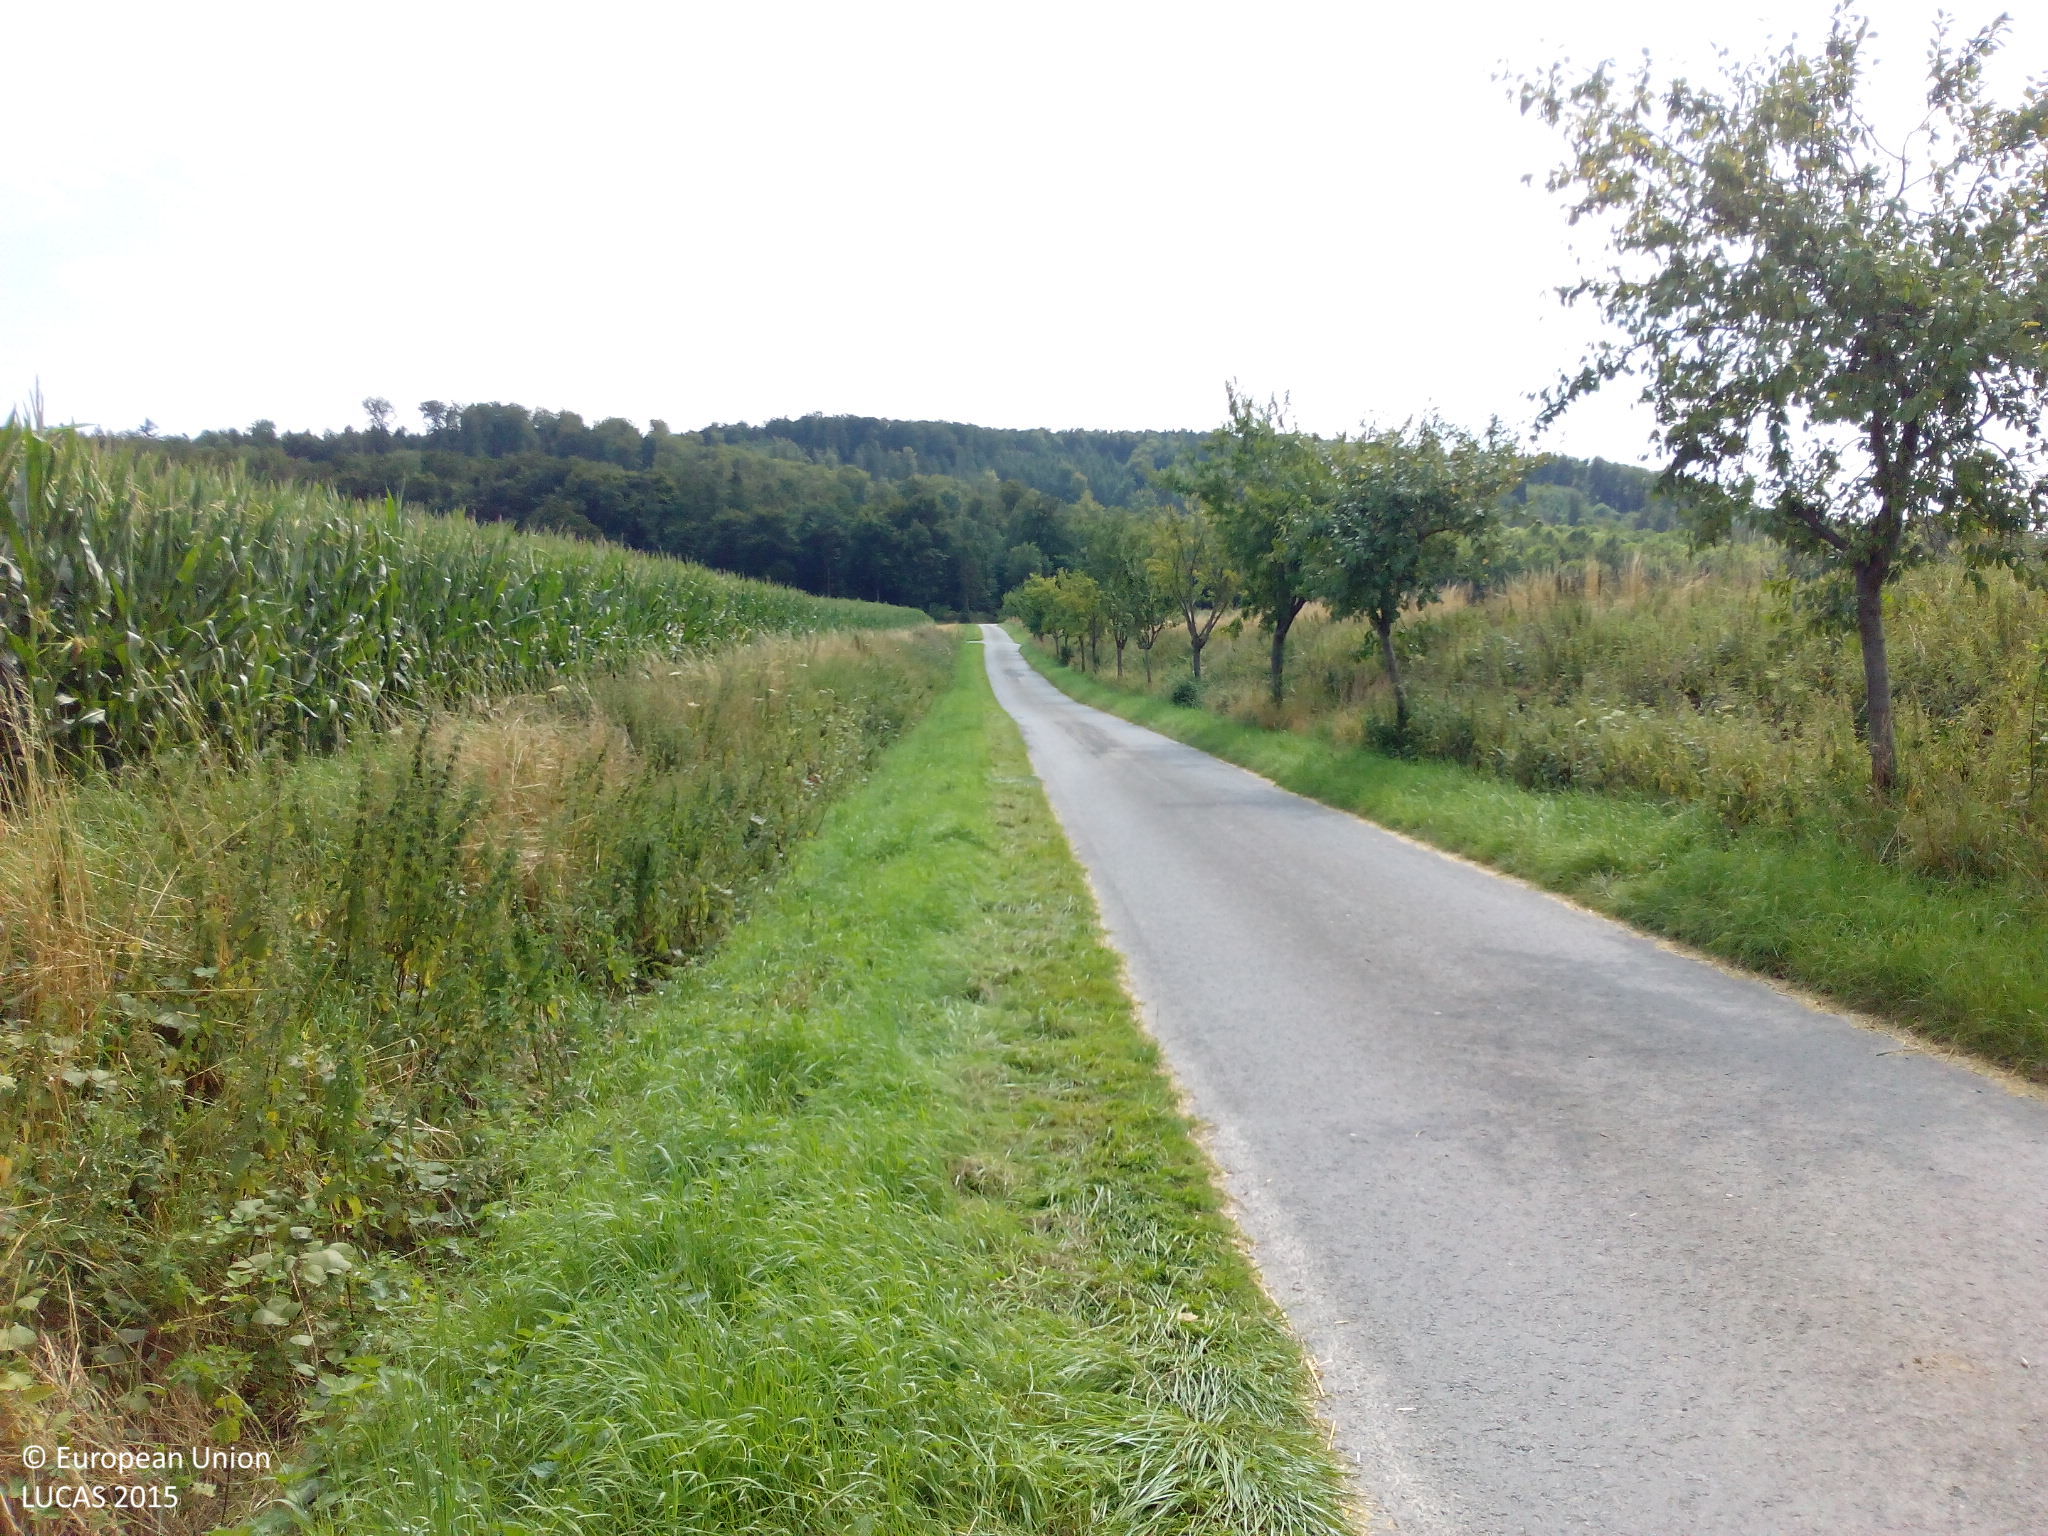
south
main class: Cropland
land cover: Maize
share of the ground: > 75 %
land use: Agriculture (excluding fallow land and kitchen gardens)
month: August
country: DE
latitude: 52.0518
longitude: 9.2857
